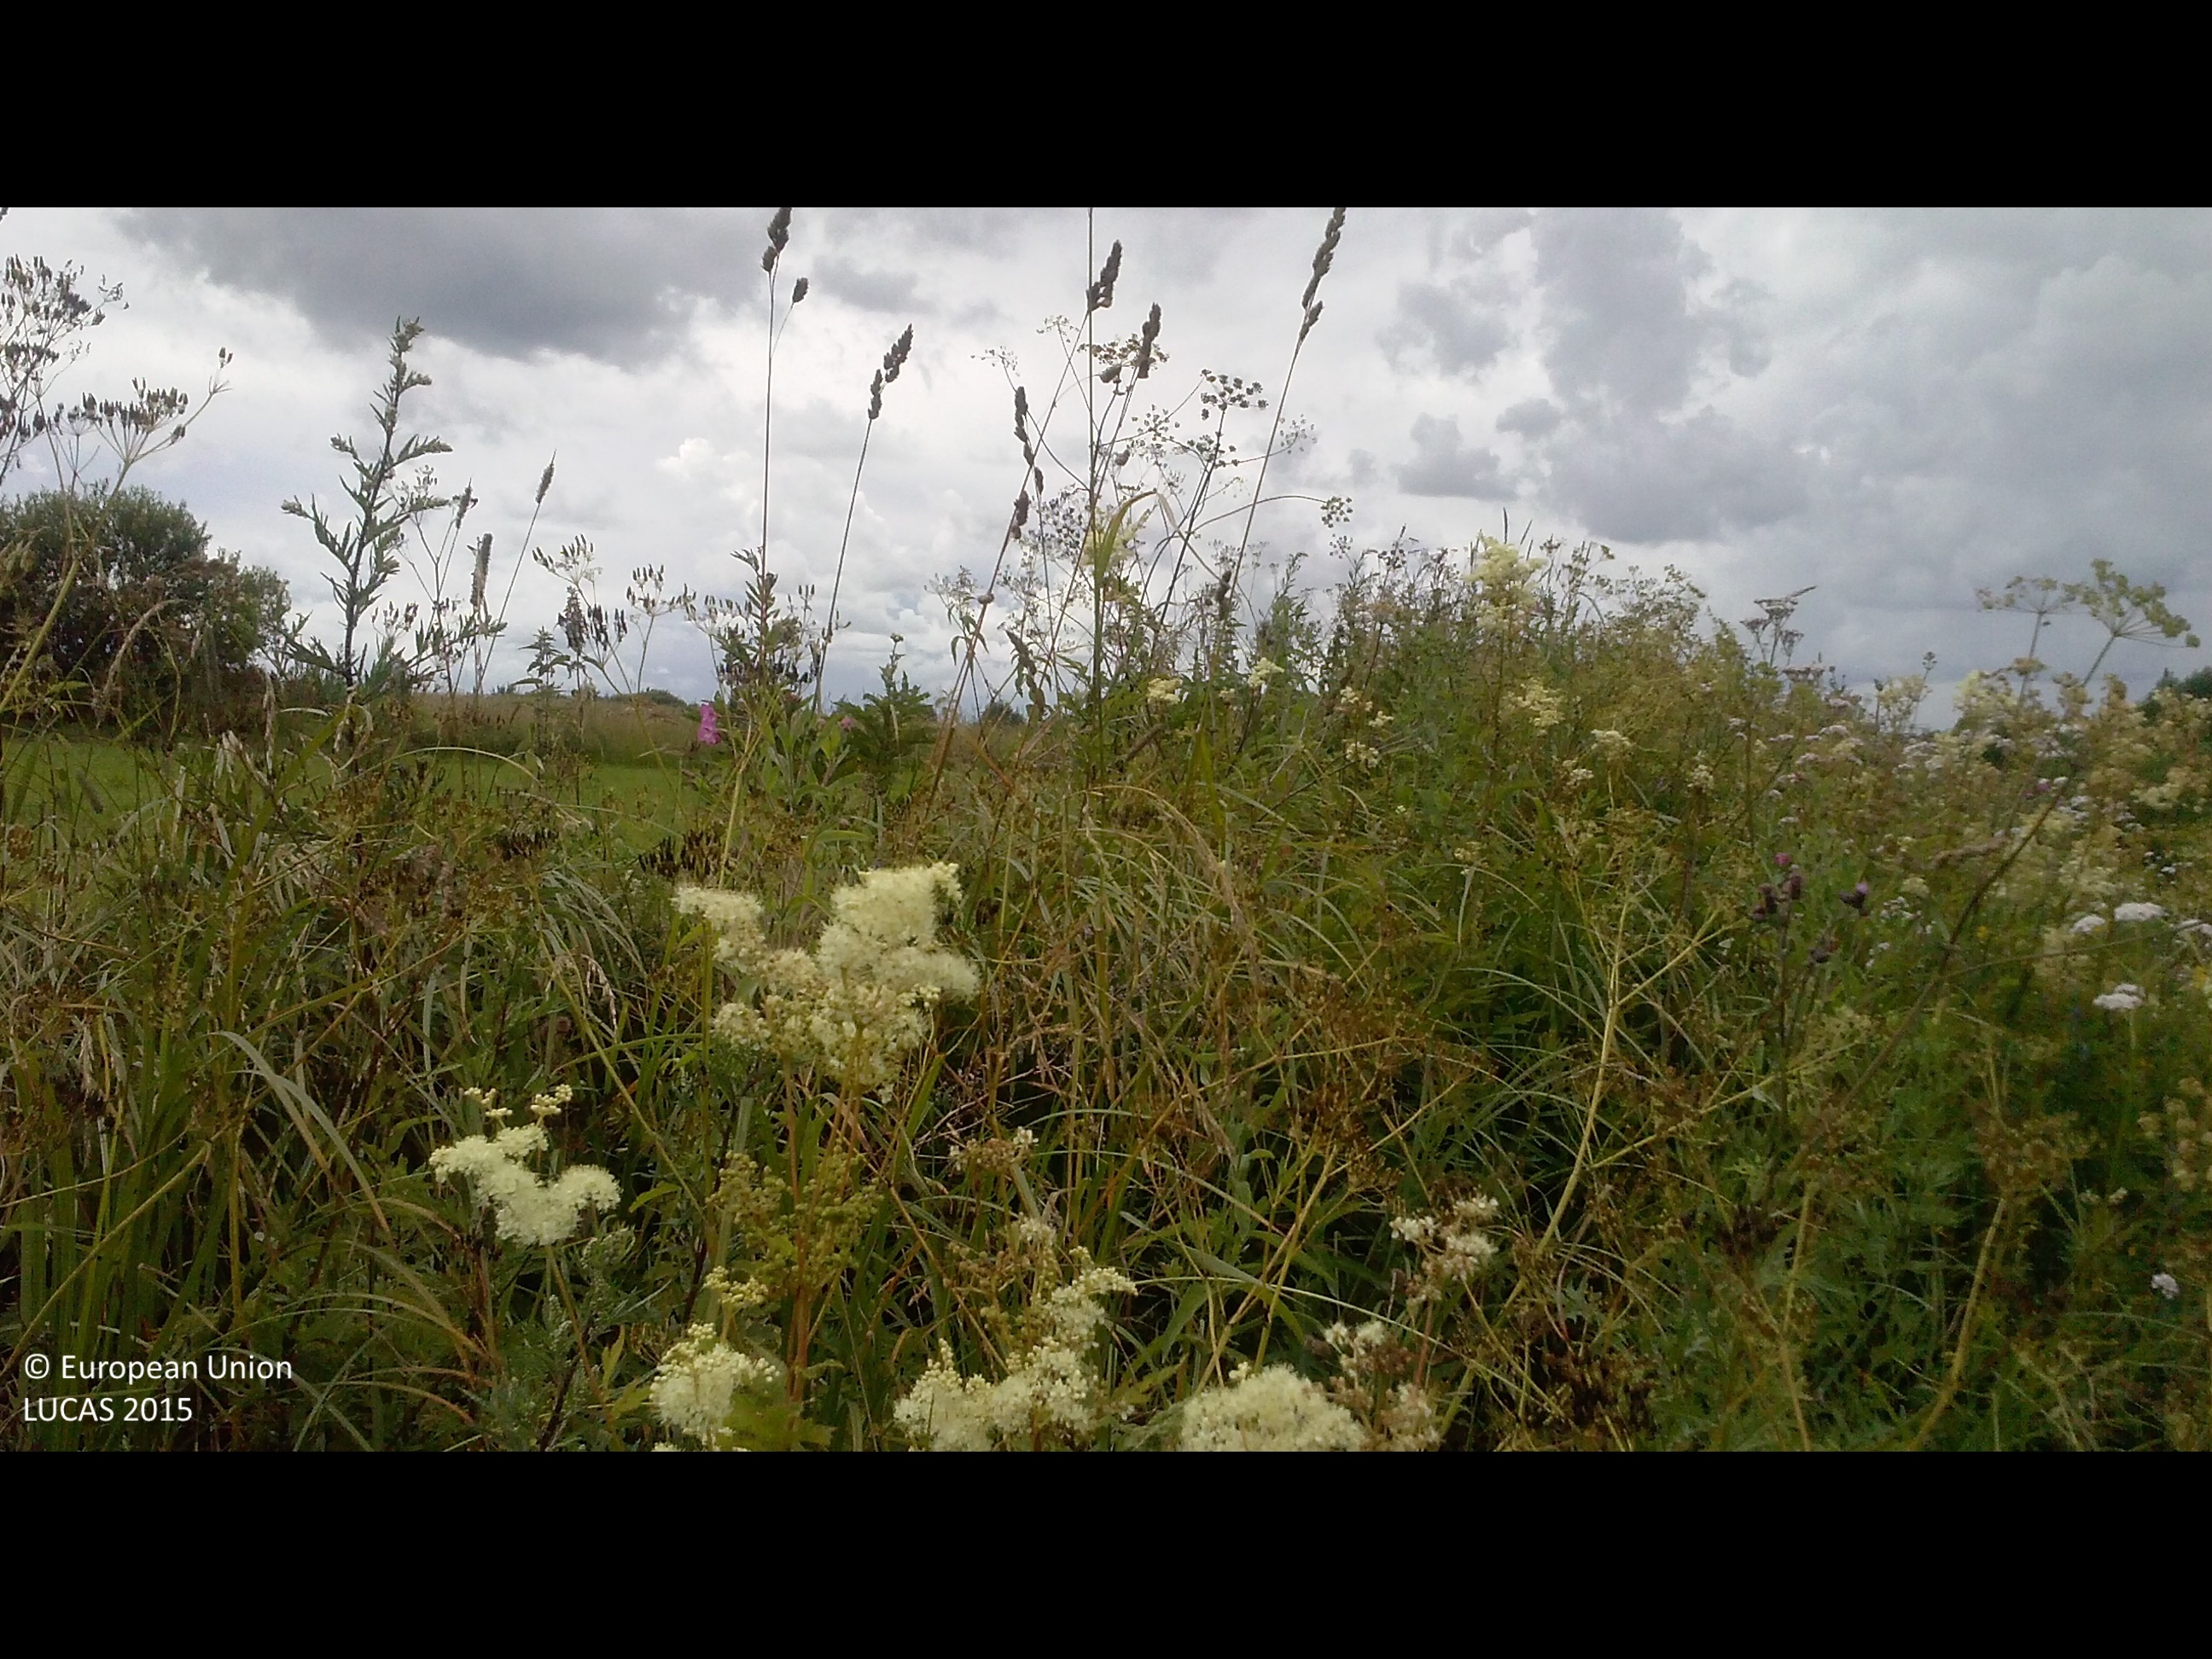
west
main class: Grassland
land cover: Spontaneously vegetated surfaces
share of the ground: > 75 %
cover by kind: herbaceous plants 100 %
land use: Semi-natural and natural areas not in use
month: July
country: LV
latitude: 56.4434
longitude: 26.9842
